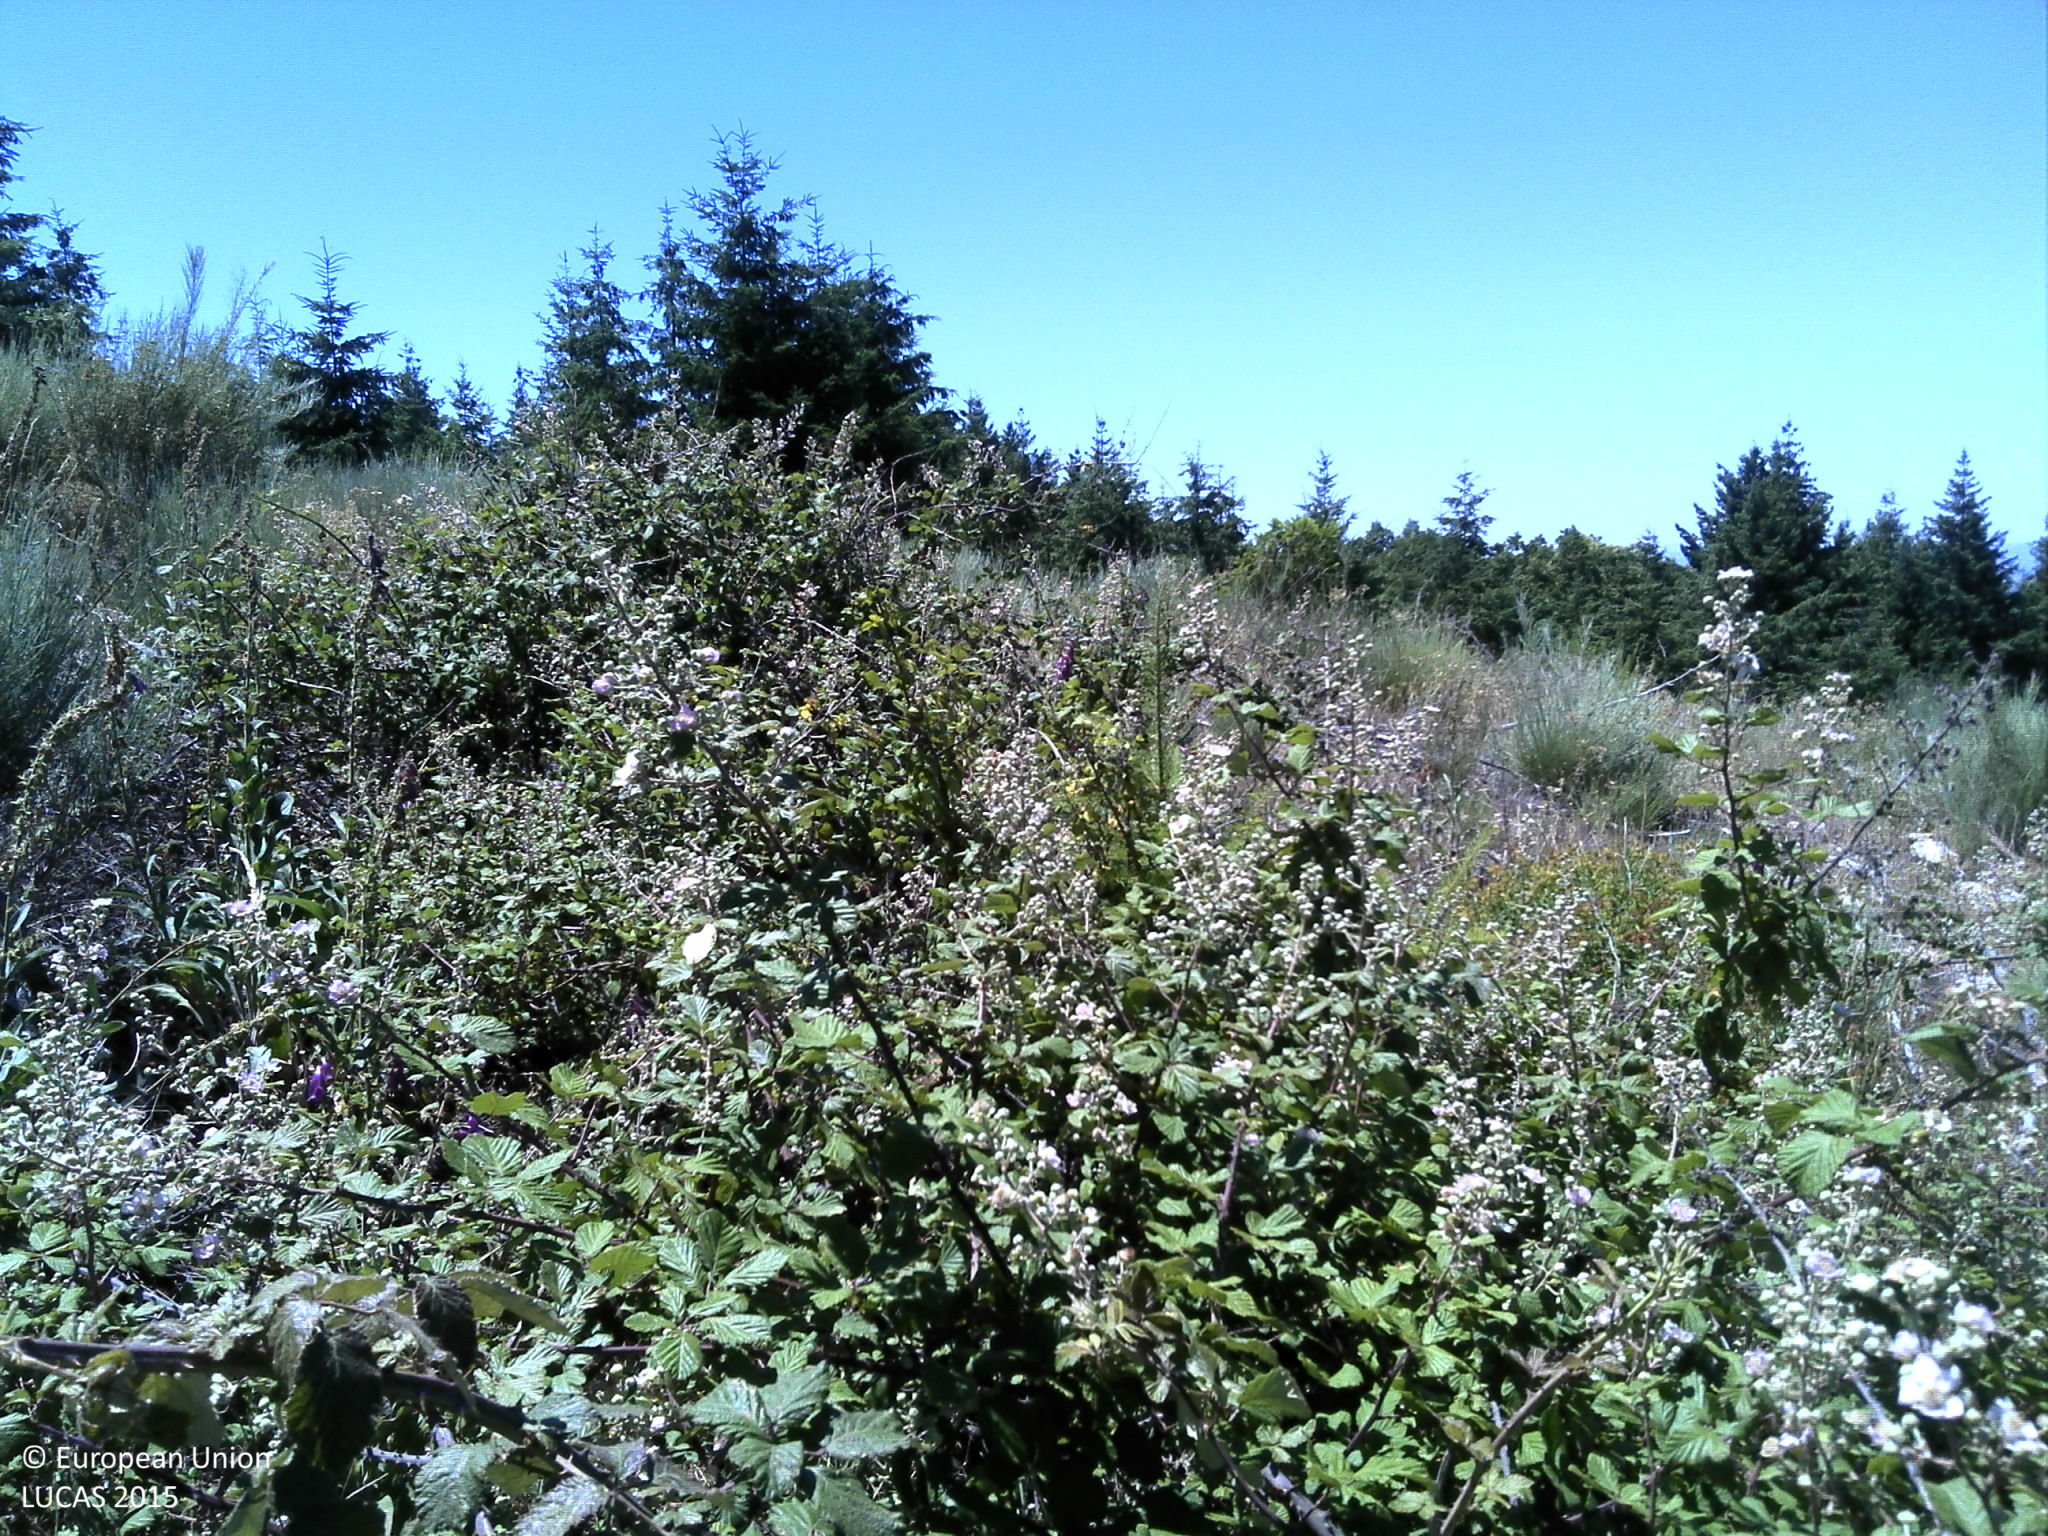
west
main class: Shrubland
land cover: Shrubland with sparse tree cover
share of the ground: > 75 %
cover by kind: shrubs 90 %, coniferous forest trees 5 %, herbaceous plants 5 %
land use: Abandoned areas
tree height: < 5 m
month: June
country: PT
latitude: 41.4652
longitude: -6.9837
